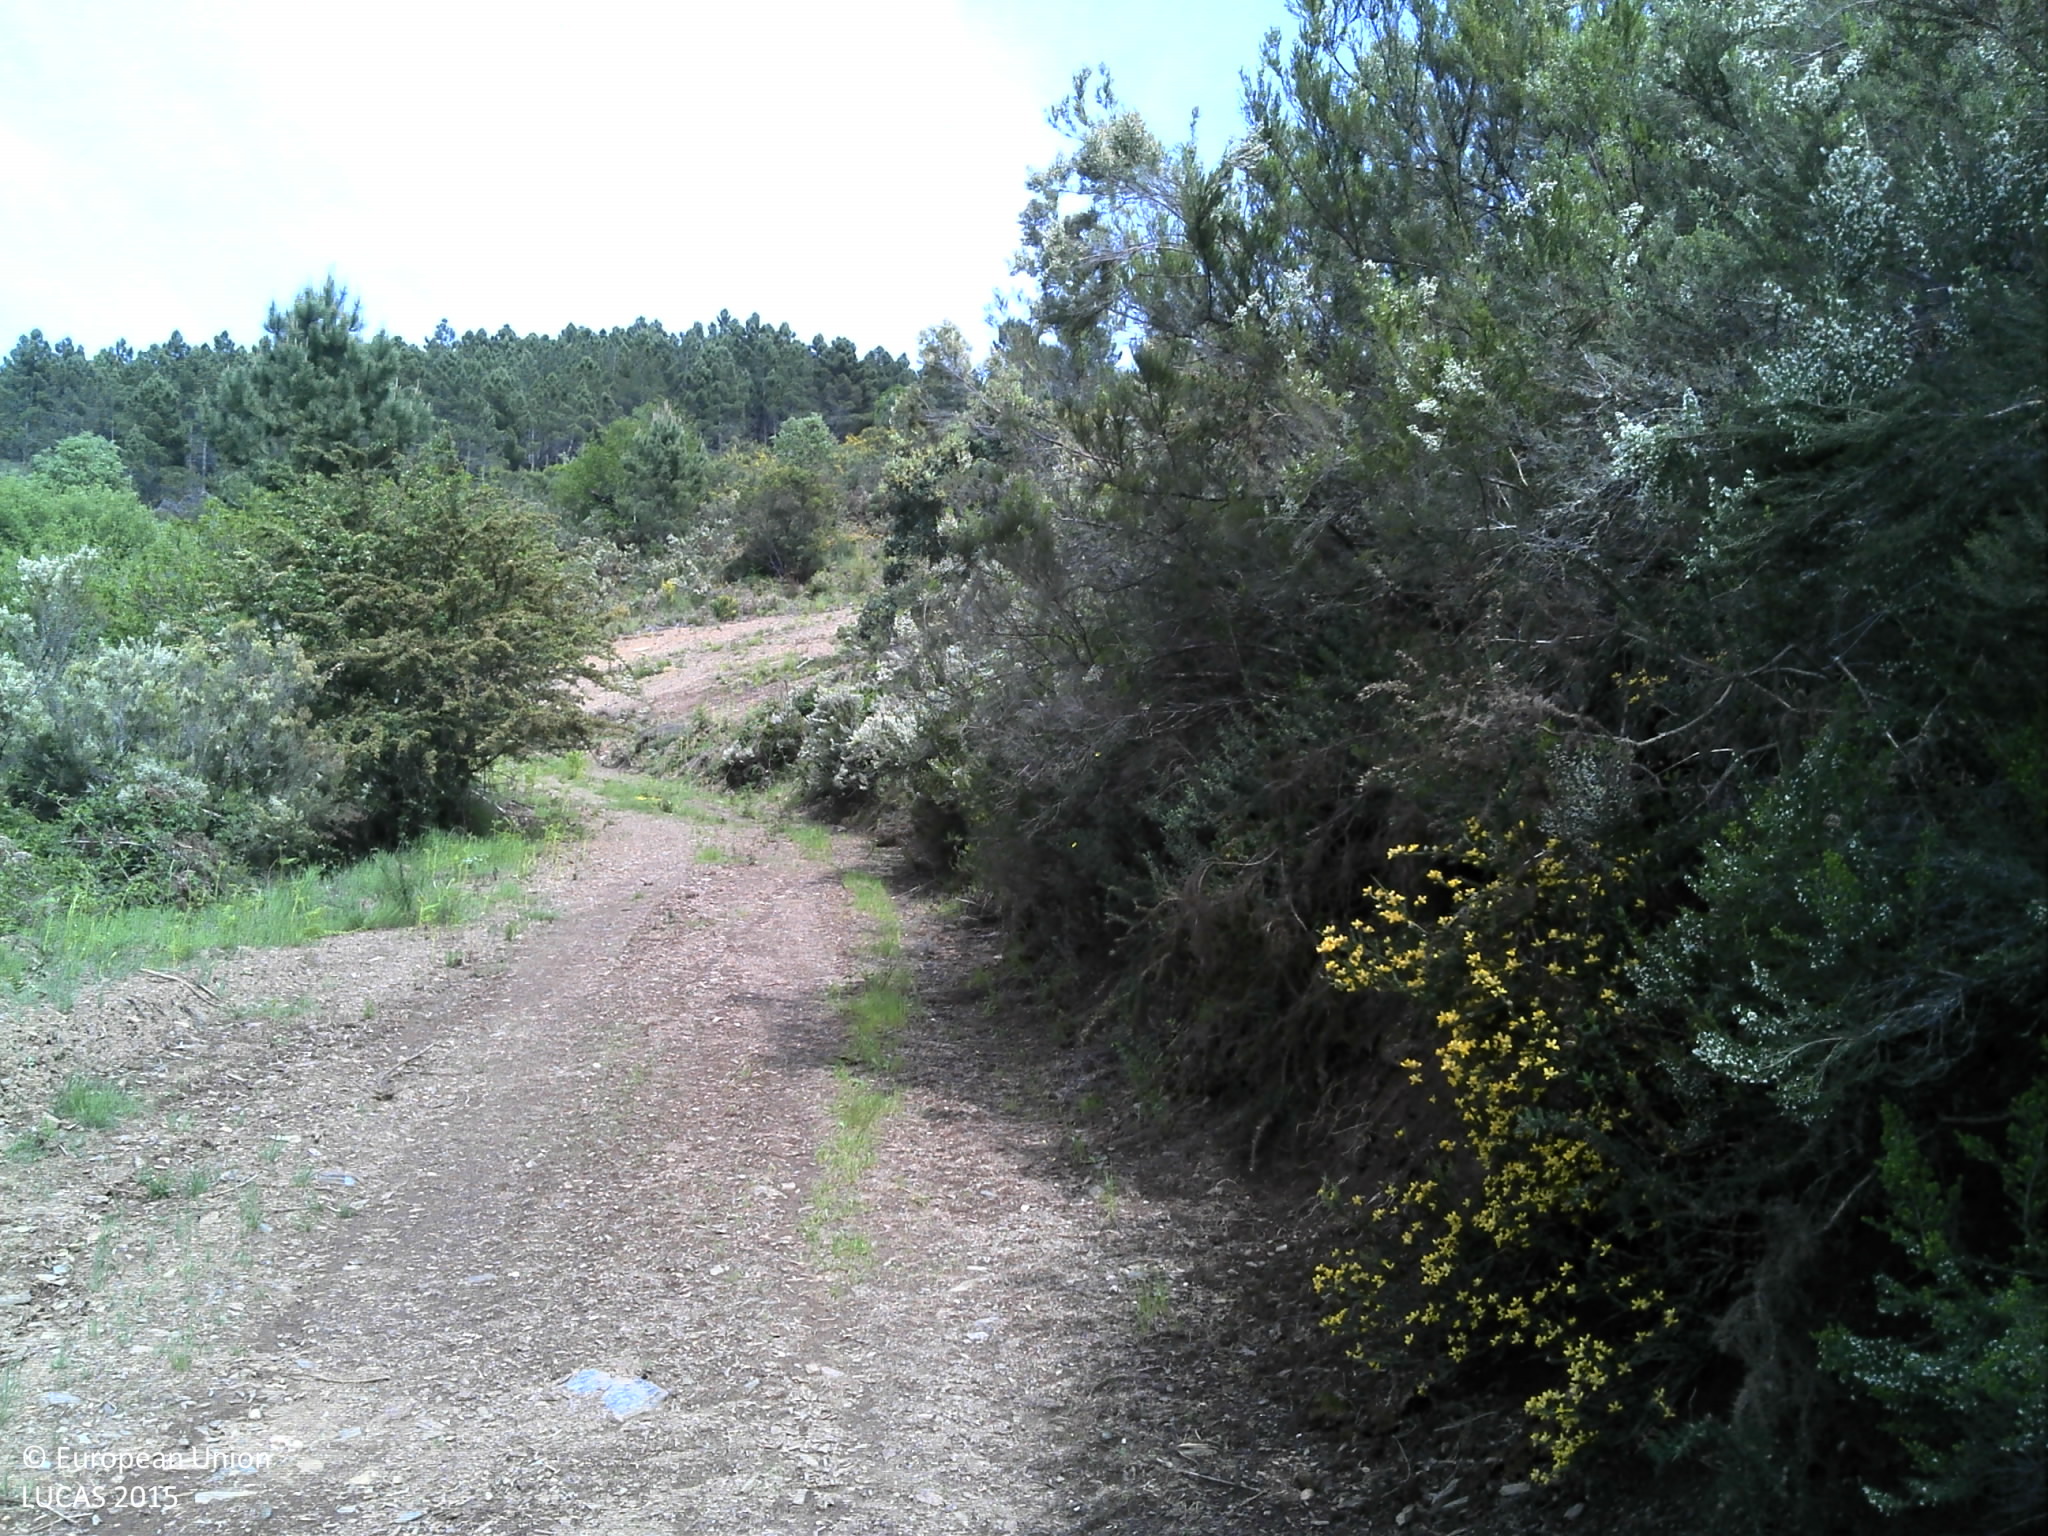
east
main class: Shrubland
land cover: Shrubland with sparse tree cover
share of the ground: > 75 %
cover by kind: shrubs 95 %, broadleaved forest trees 5 %
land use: Forestry
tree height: > 5 m
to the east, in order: Shrubland with sparse tree cover; Grass margins; Tracks; Shrubland with sparse tree cover; Other bare soil; Shrubland with sparse tree cover; Tracks; Shrubland with sparse tree cover; Pine dominated coniferous woodland
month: May
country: PT
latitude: 41.9526
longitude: -7.1470
